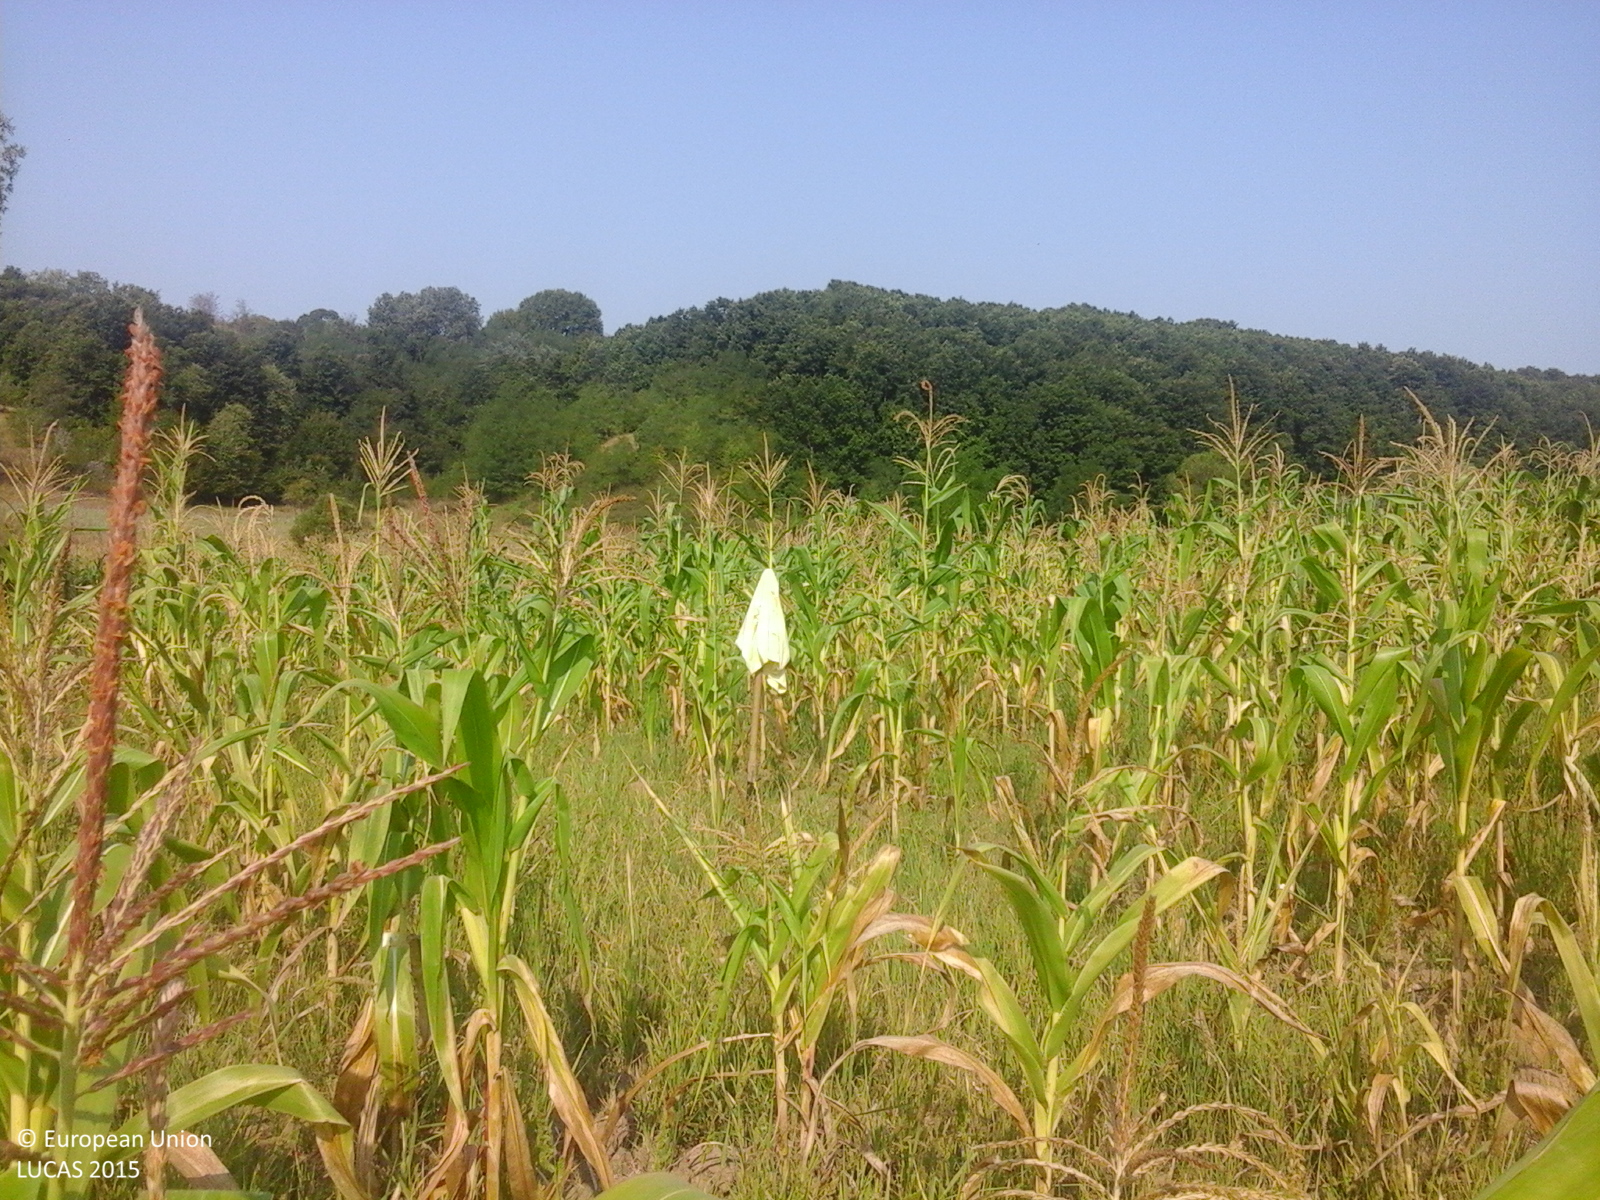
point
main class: Cropland
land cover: Maize
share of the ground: > 75 %
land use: Agriculture (excluding fallow land and kitchen gardens)
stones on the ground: < 10 %
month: August
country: RO
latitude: 44.6214
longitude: 23.8609
